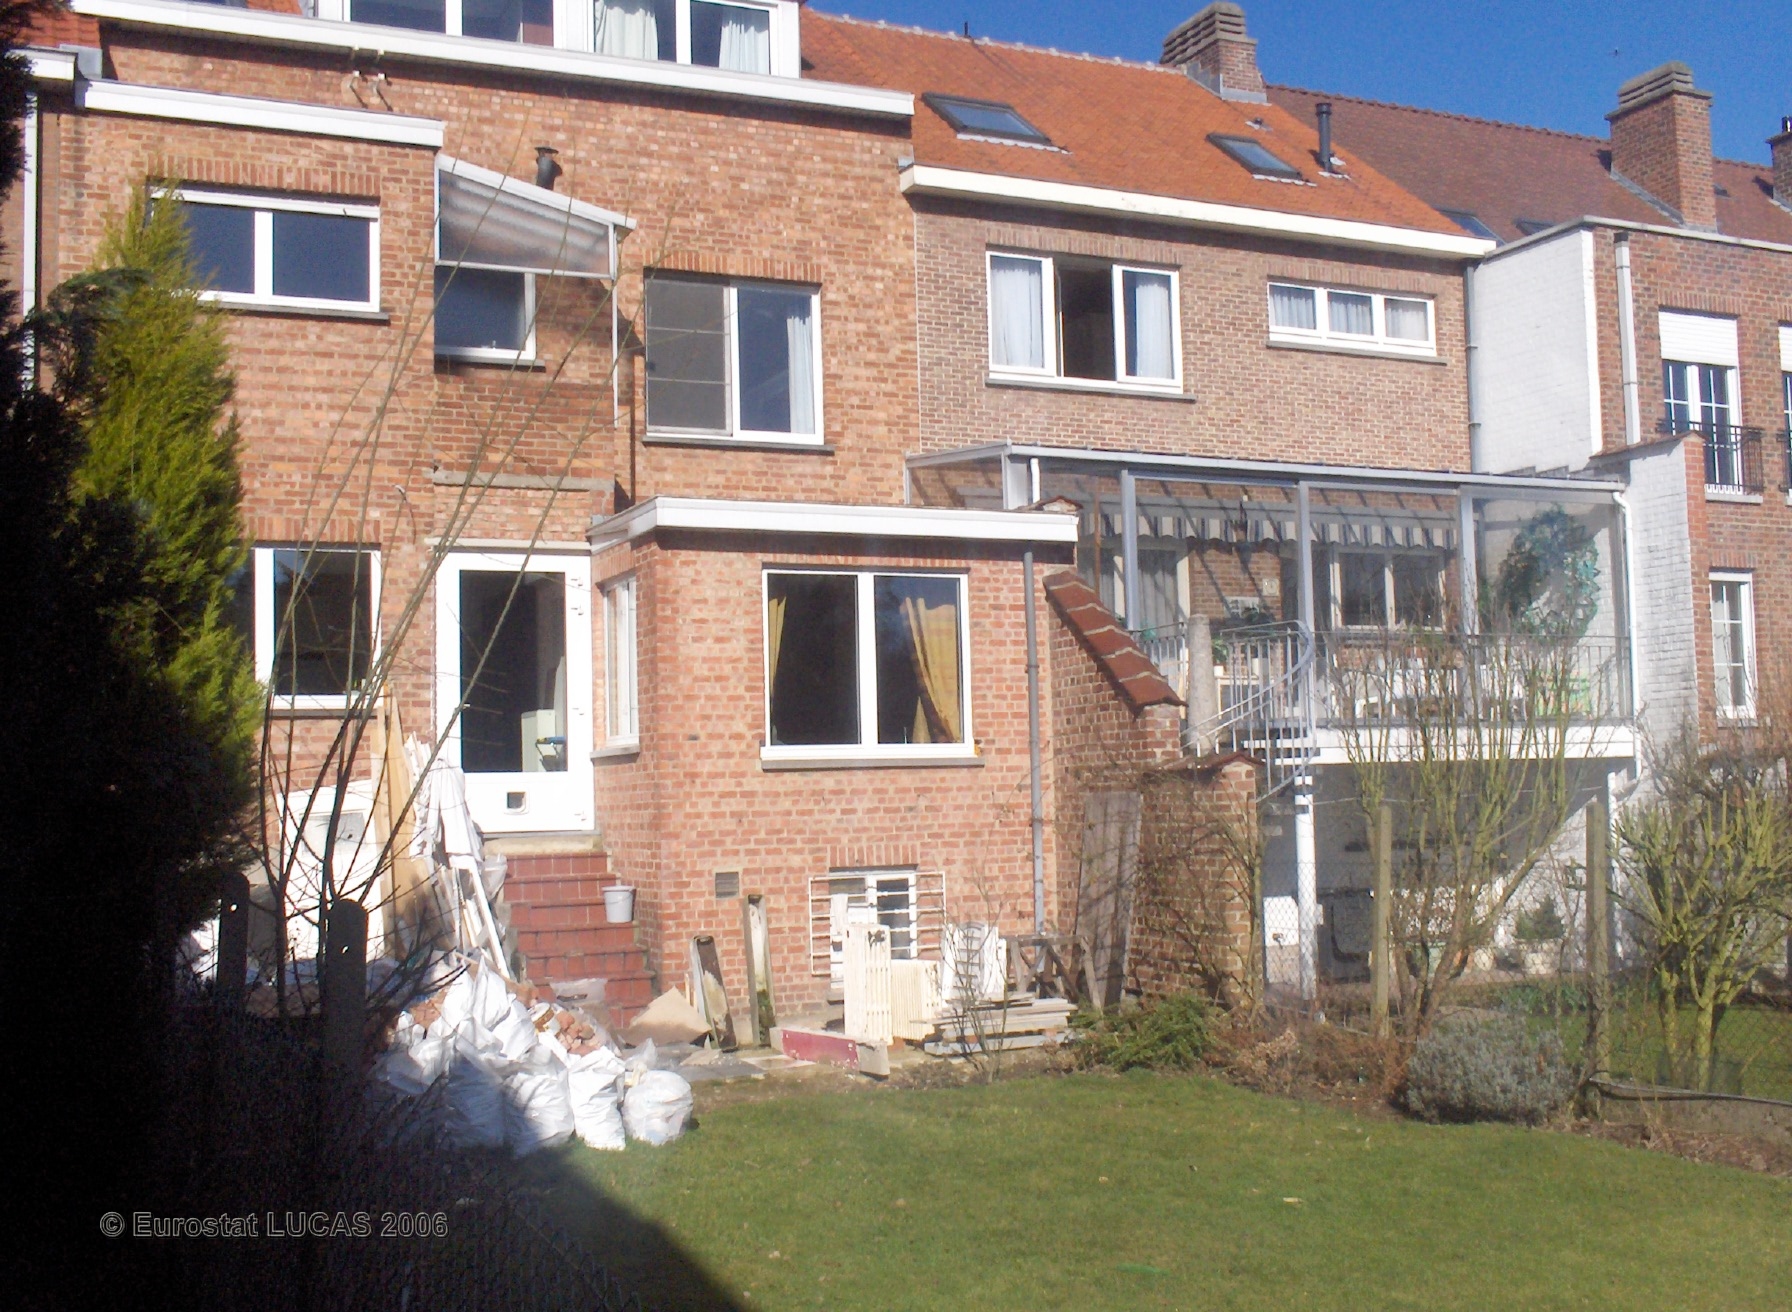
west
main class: Grassland
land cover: Grassland without tree/shrub cover
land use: Residential
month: March
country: BE
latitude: 50.8432
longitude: 4.4712
